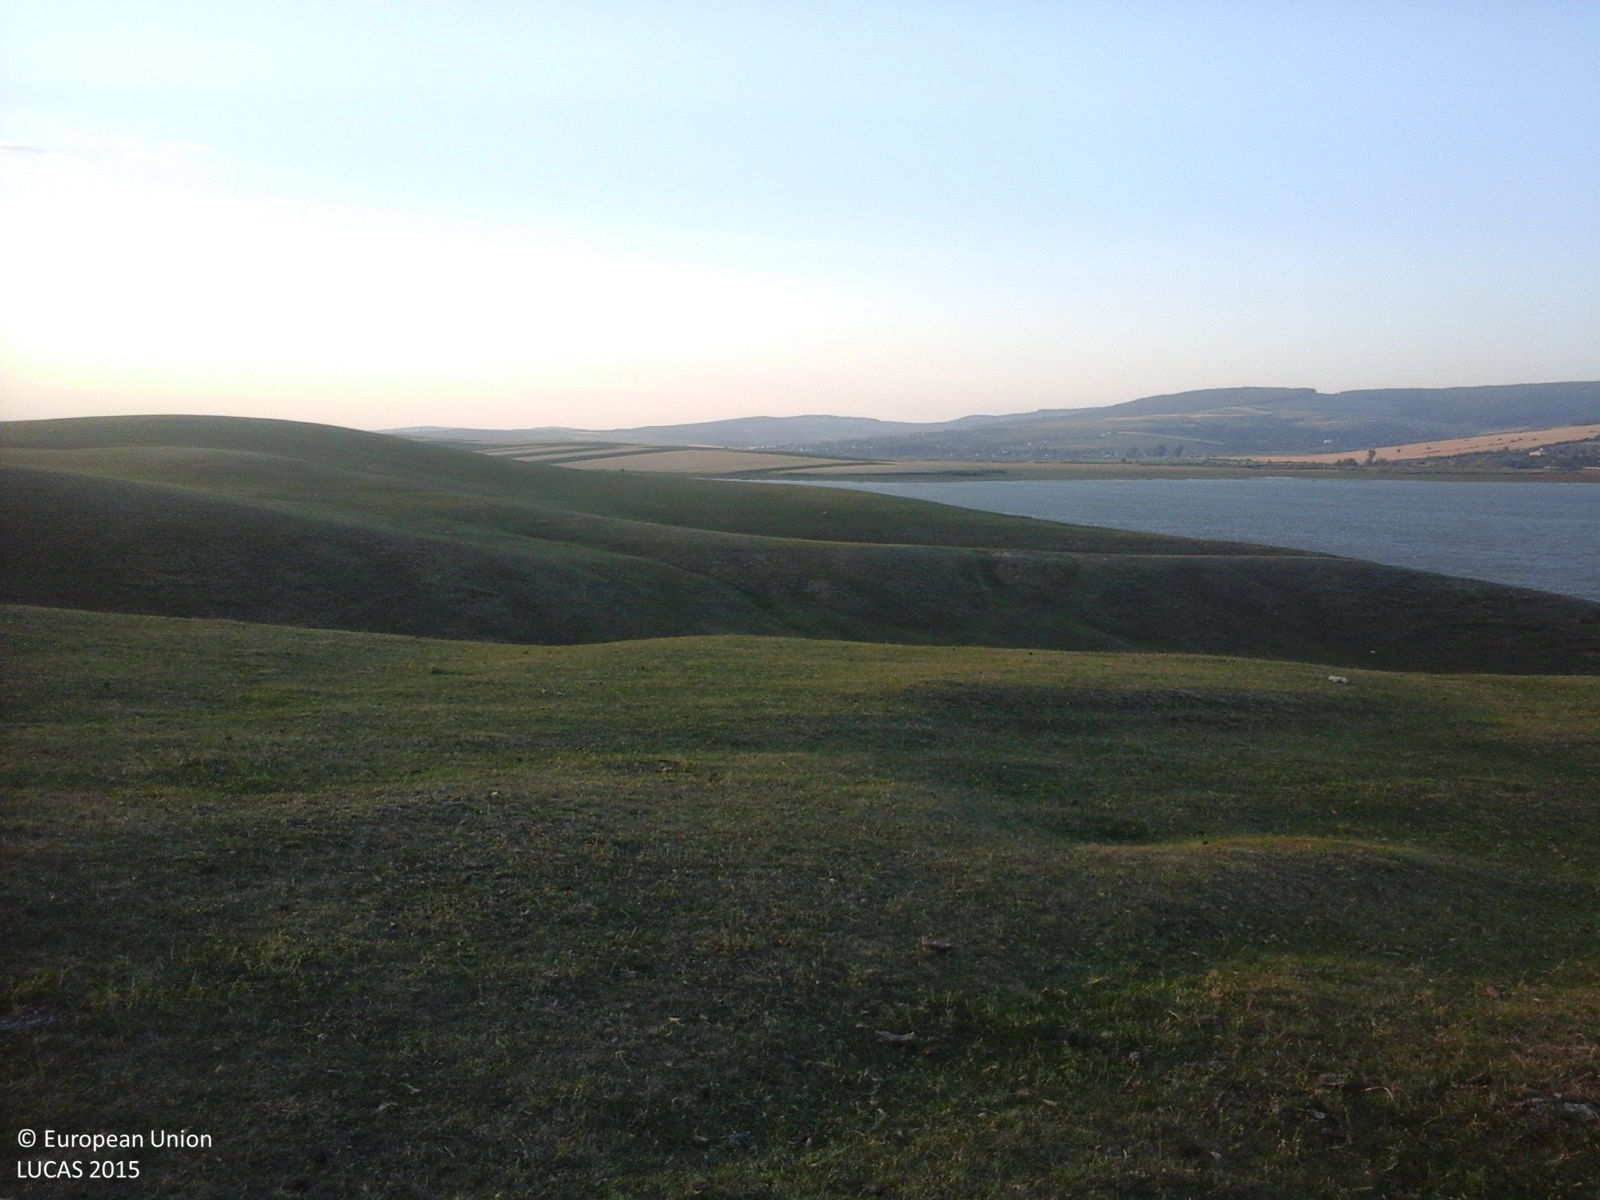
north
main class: Grassland
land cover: Grassland without tree/shrub cover
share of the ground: > 75 %
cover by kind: herbaceous plants 100 %
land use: Agriculture (excluding fallow land and kitchen gardens)
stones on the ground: < 10 %
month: June
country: RO
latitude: 46.9467
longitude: 27.3331
